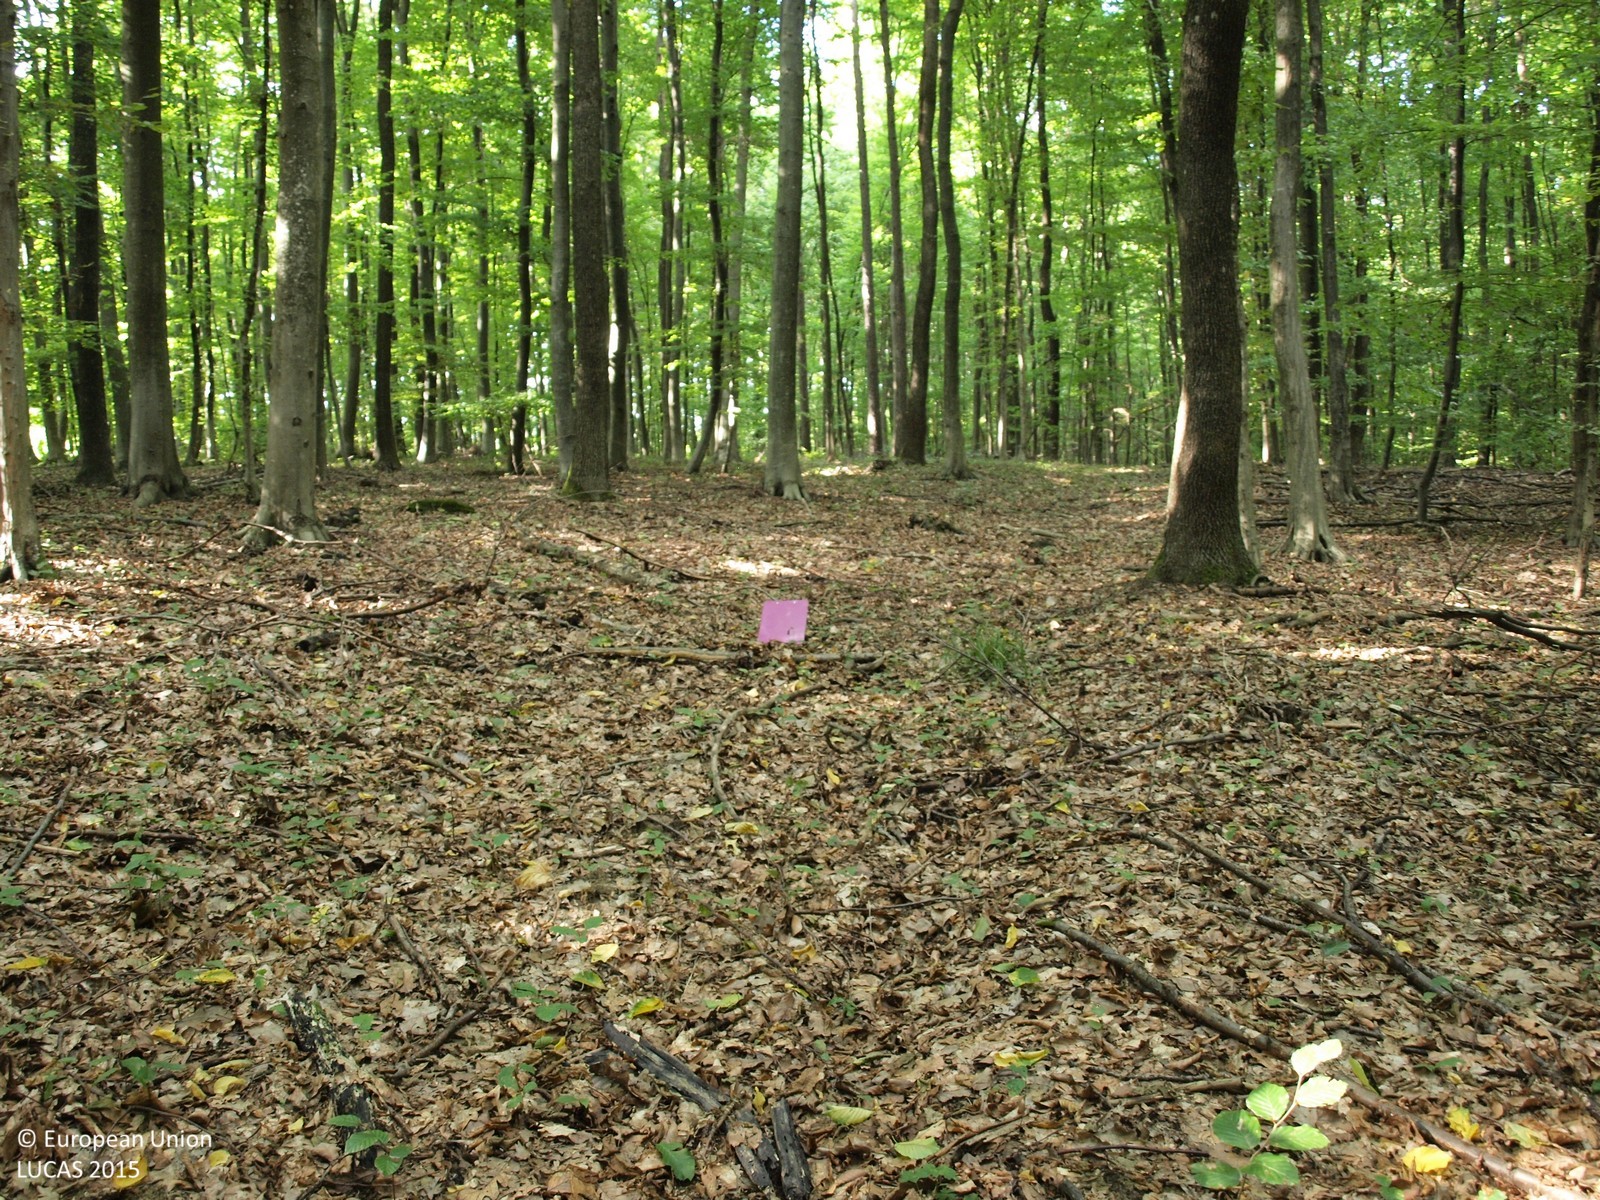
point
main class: Woodland
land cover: Broadleaved woodland
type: mesophytic deciduous forest
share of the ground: > 75 %
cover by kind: broadleaved forest trees 100 %
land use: Forestry
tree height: > 5 m
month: August
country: HR
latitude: 46.0371
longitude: 16.6287
